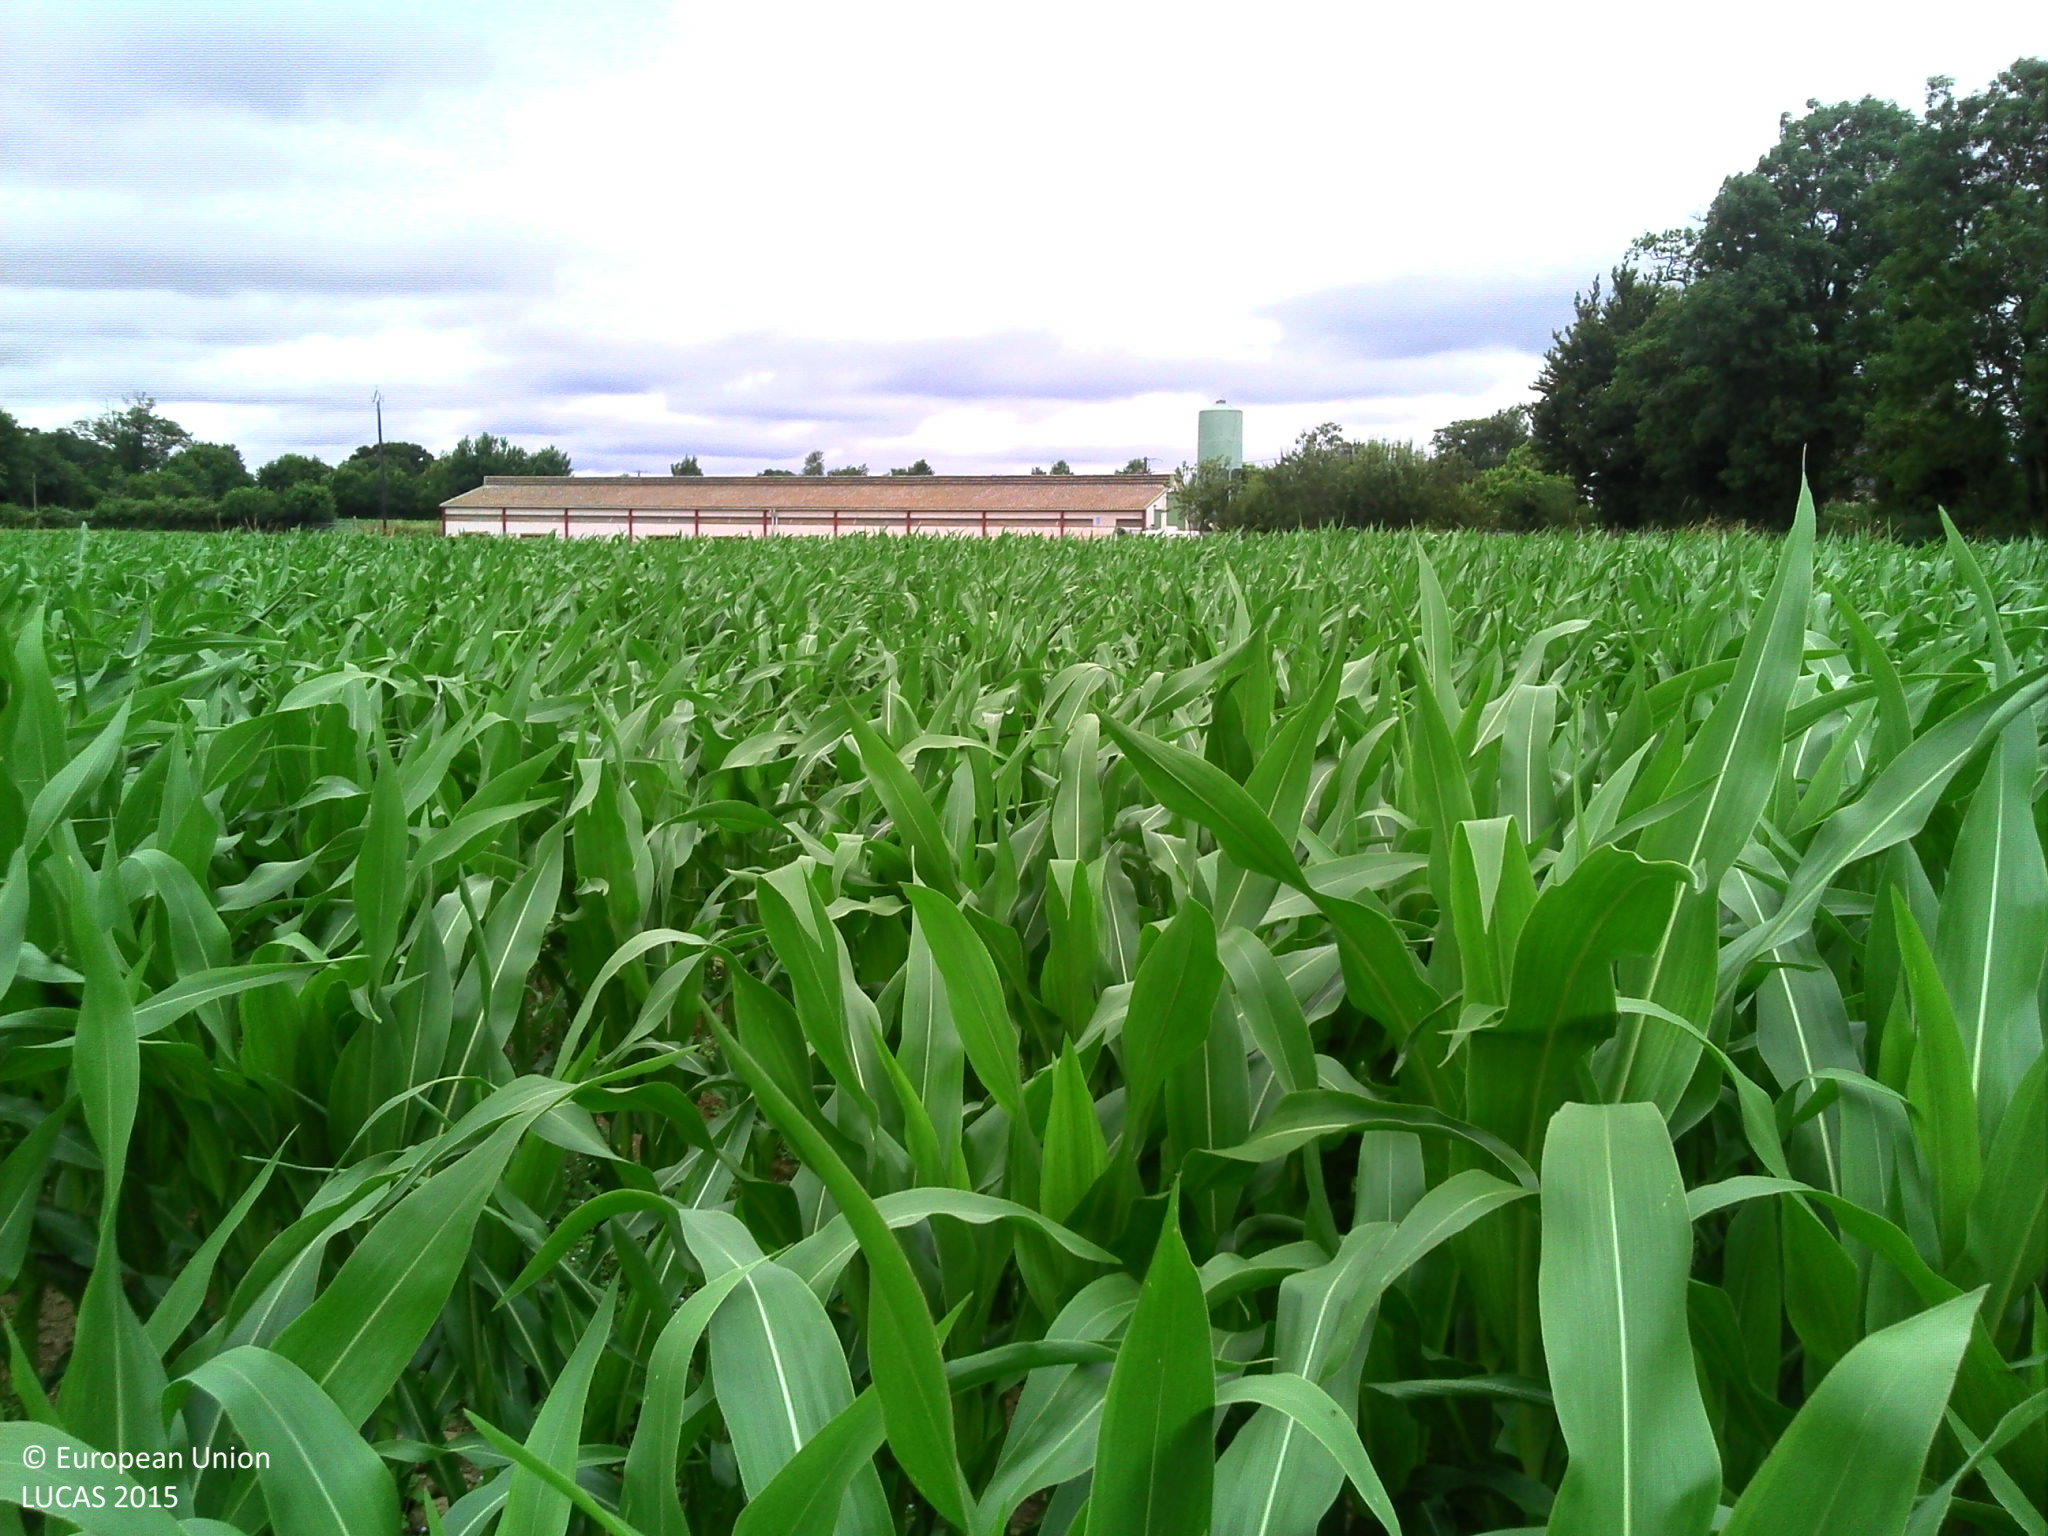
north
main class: Cropland
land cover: Maize
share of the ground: > 75 %
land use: Agriculture (excluding fallow land and kitchen gardens)
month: July
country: FR
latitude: 48.9446
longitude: -1.3377
